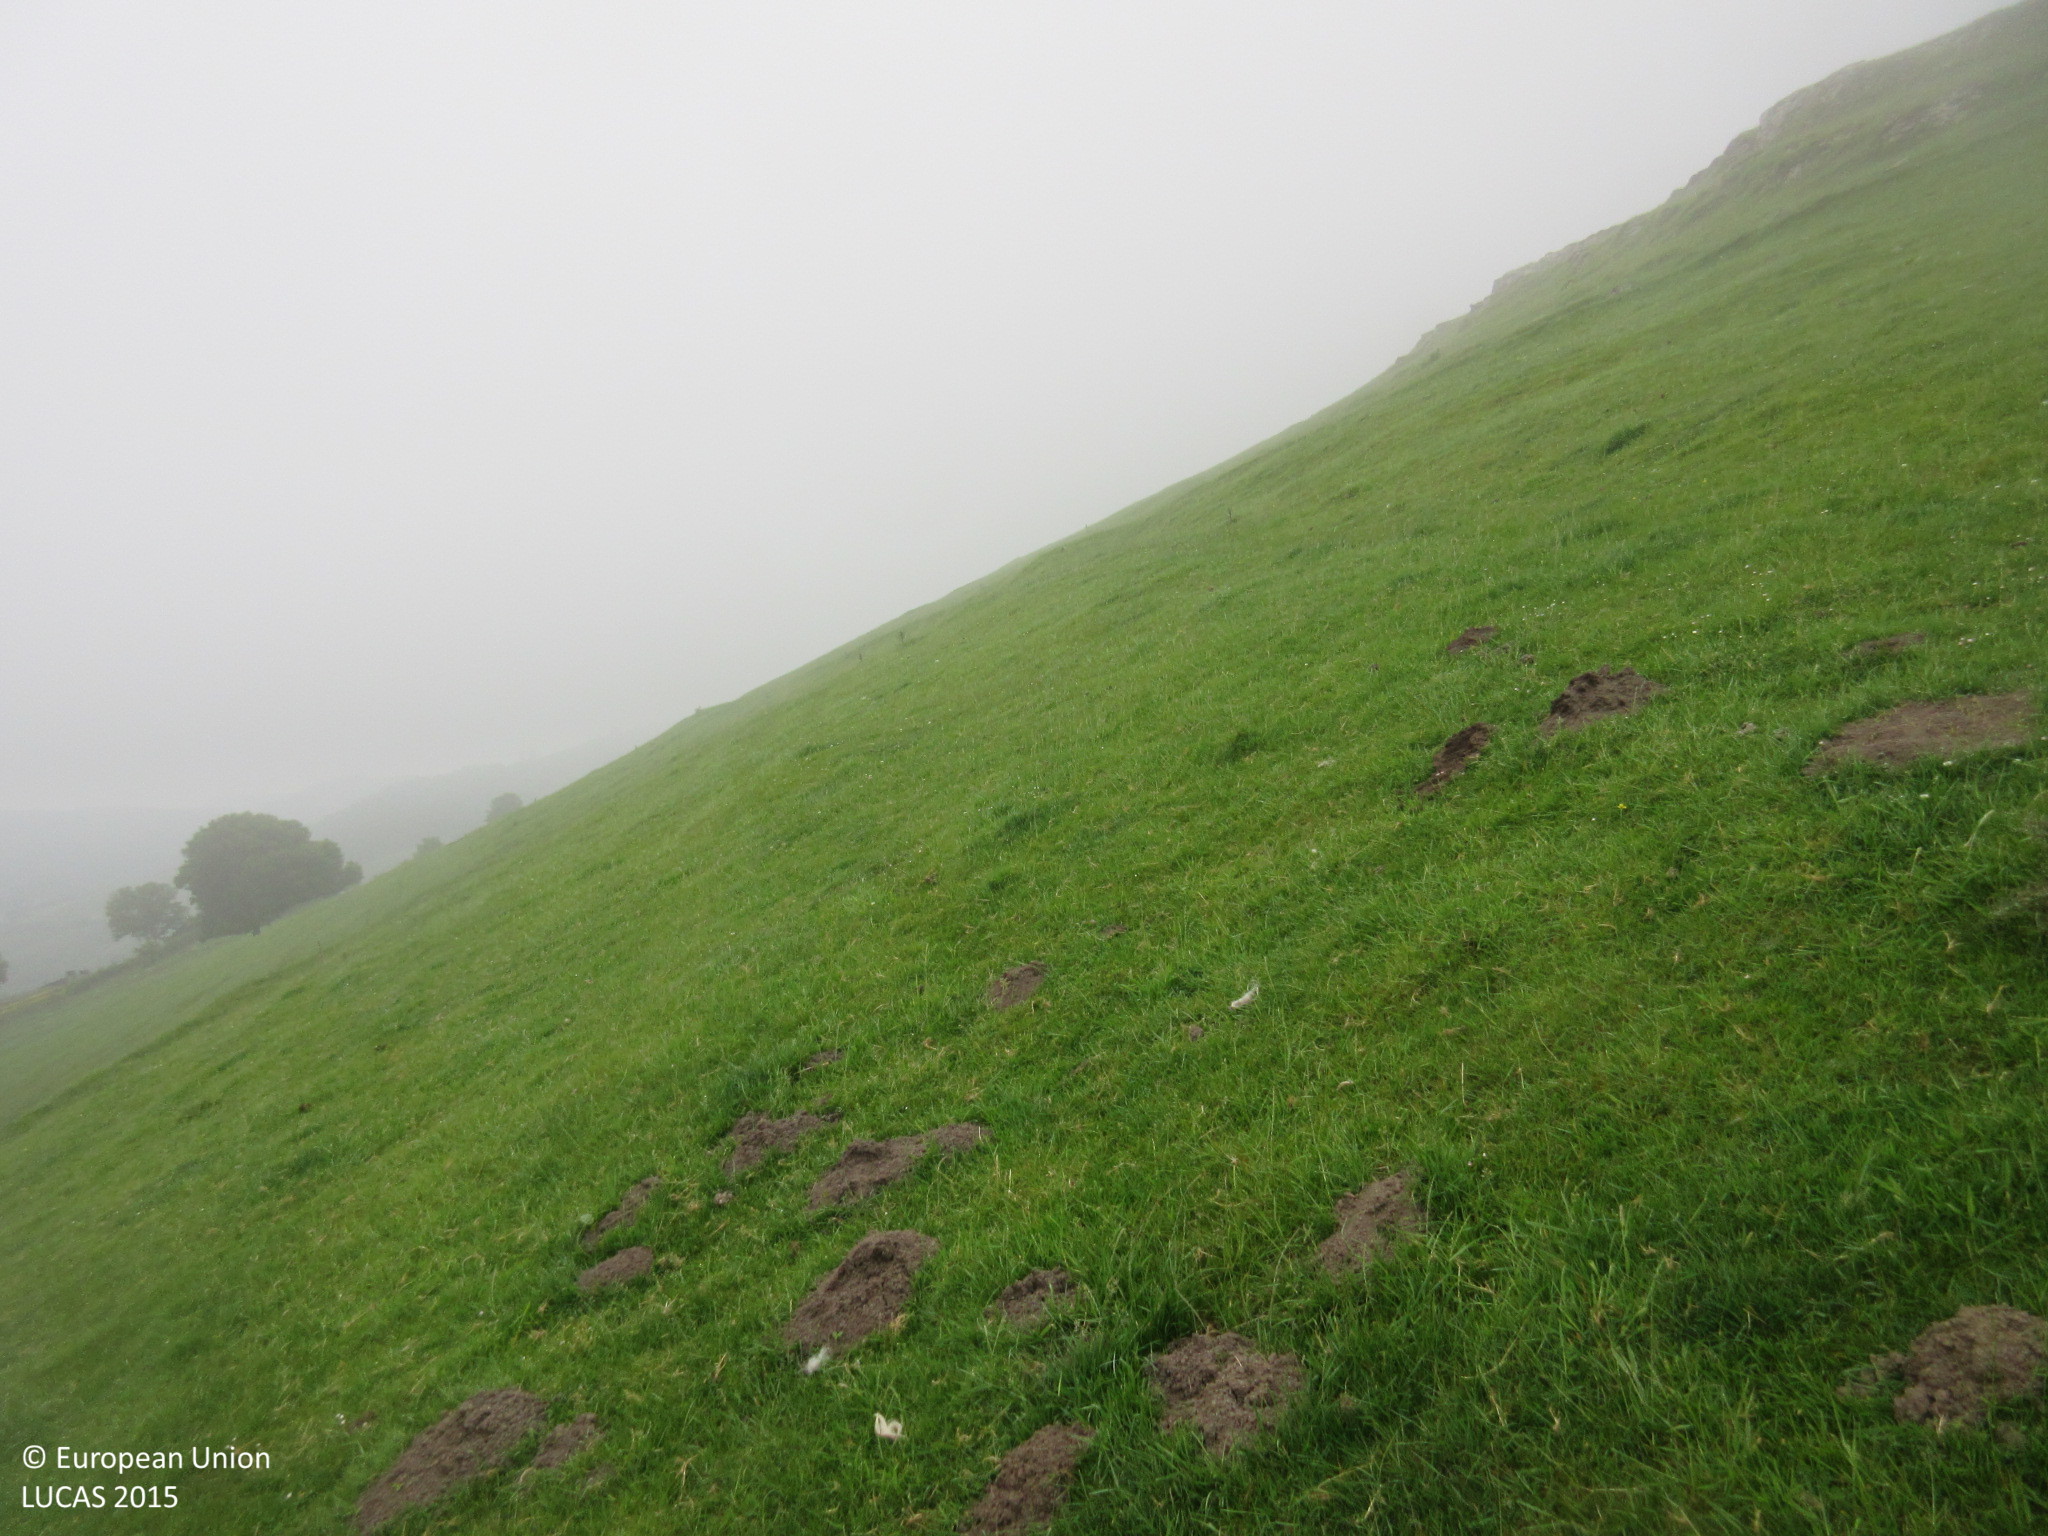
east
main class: Grassland
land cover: Grassland without tree/shrub cover
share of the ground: > 75 %
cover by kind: herbaceous plants 100 %
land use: Agriculture (excluding fallow land and kitchen gardens)
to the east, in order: Grassland without tree/shrub cover; Rock outcrops; Grassland without tree/shrub cover; Rock outcrops; Grassland without tree/shrub cover; Fences; Shruby margins; Grassland without tree/shrub cover
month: June
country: ES
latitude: 43.3648
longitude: -3.5565
